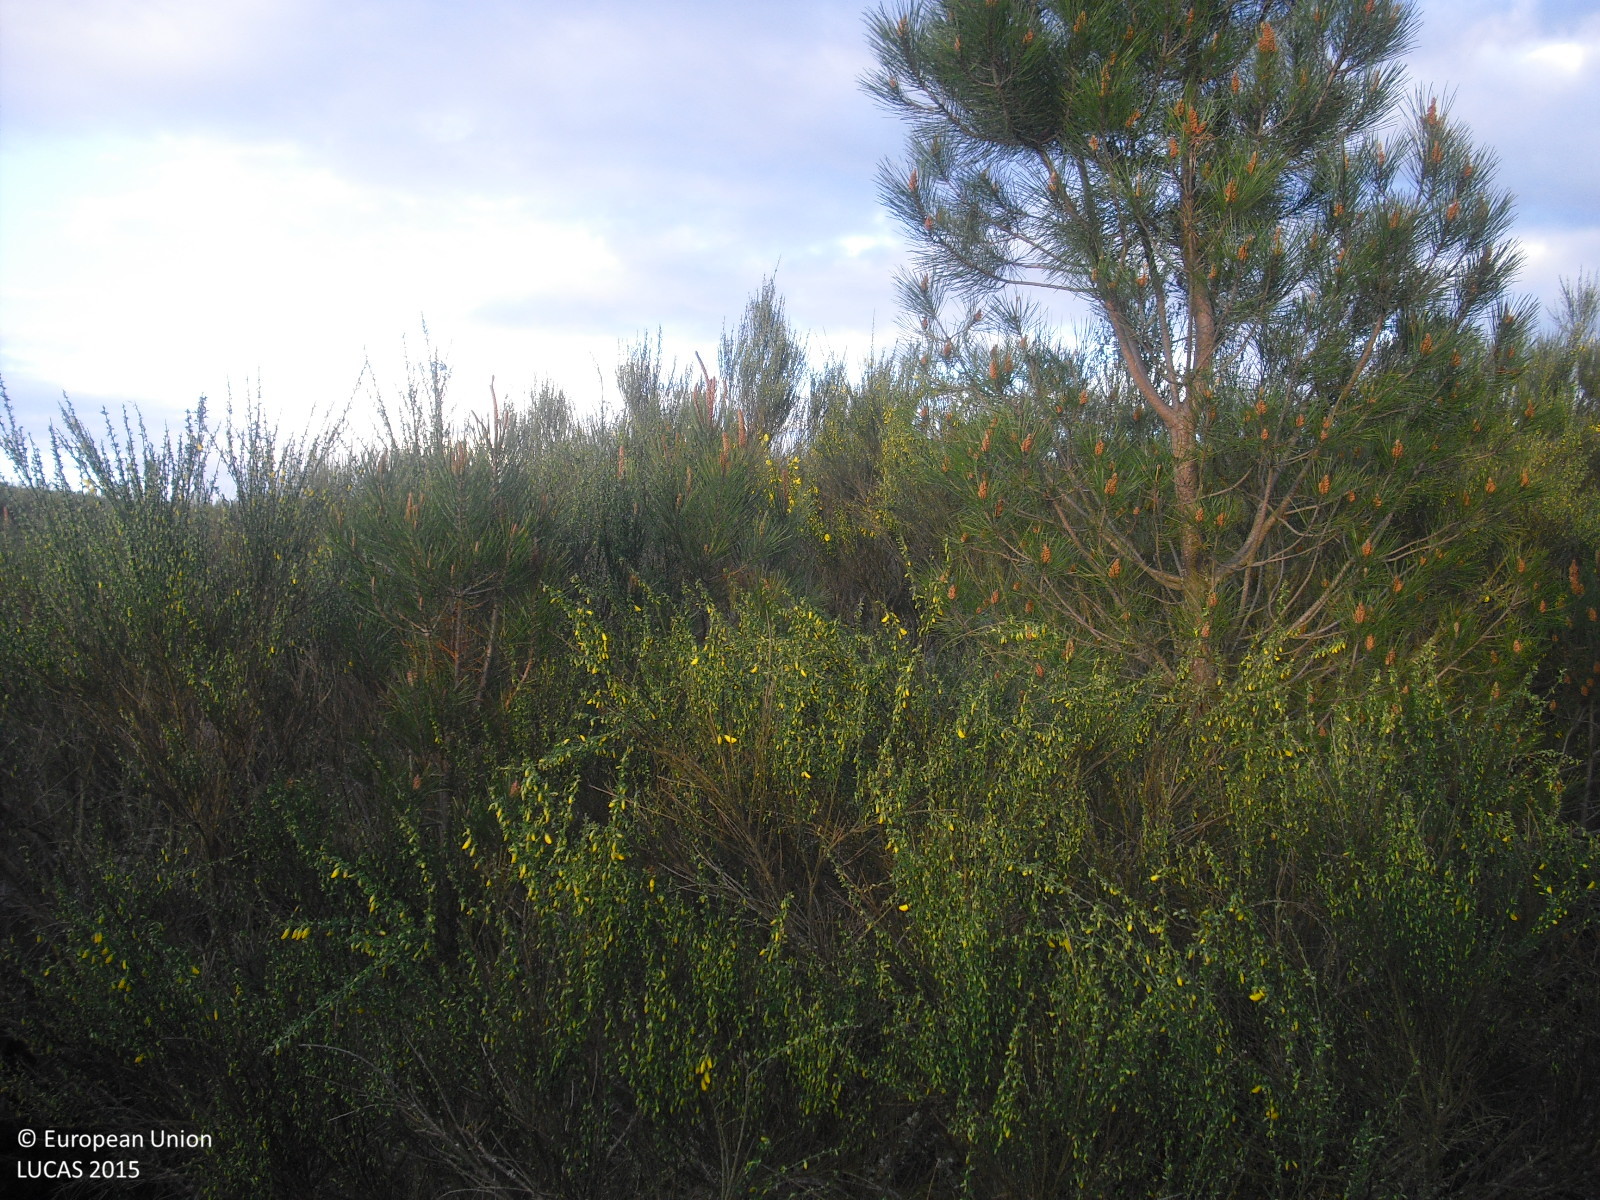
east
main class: Shrubland
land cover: Shrubland with sparse tree cover
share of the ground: 50 - 75 %
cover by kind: shrubs 75 %, consolidated bare surface 20 %, coniferous forest trees 5 %
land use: Semi-natural and natural areas not in use
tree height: < 5 m
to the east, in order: Shrubland with sparse tree cover; Shrubland without tree cover; Shrubland with sparse tree cover; Dry stone walls; Shrubland with sparse tree cover; Rock outcrops; Shrubland with sparse tree cover; Dry stone walls; Shrubland with sparse tree cover; Dry stone walls; Shrubland with sparse tree cover; Tracks; Rock outcrops; Shrubland with sparse tree cover; Dry stone walls; Shrubland without tree cover; Tracks; Ditches and canals; Shrubland without tree cover; Grassland with sparse tree/shrub cover; Shrubland without tree cover; Ditches and canals; Grass margins; Tracks; Grass margins; Ditches and canals; Shrubland without tree cover
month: April
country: ES
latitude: 41.9082
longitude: -7.5056
